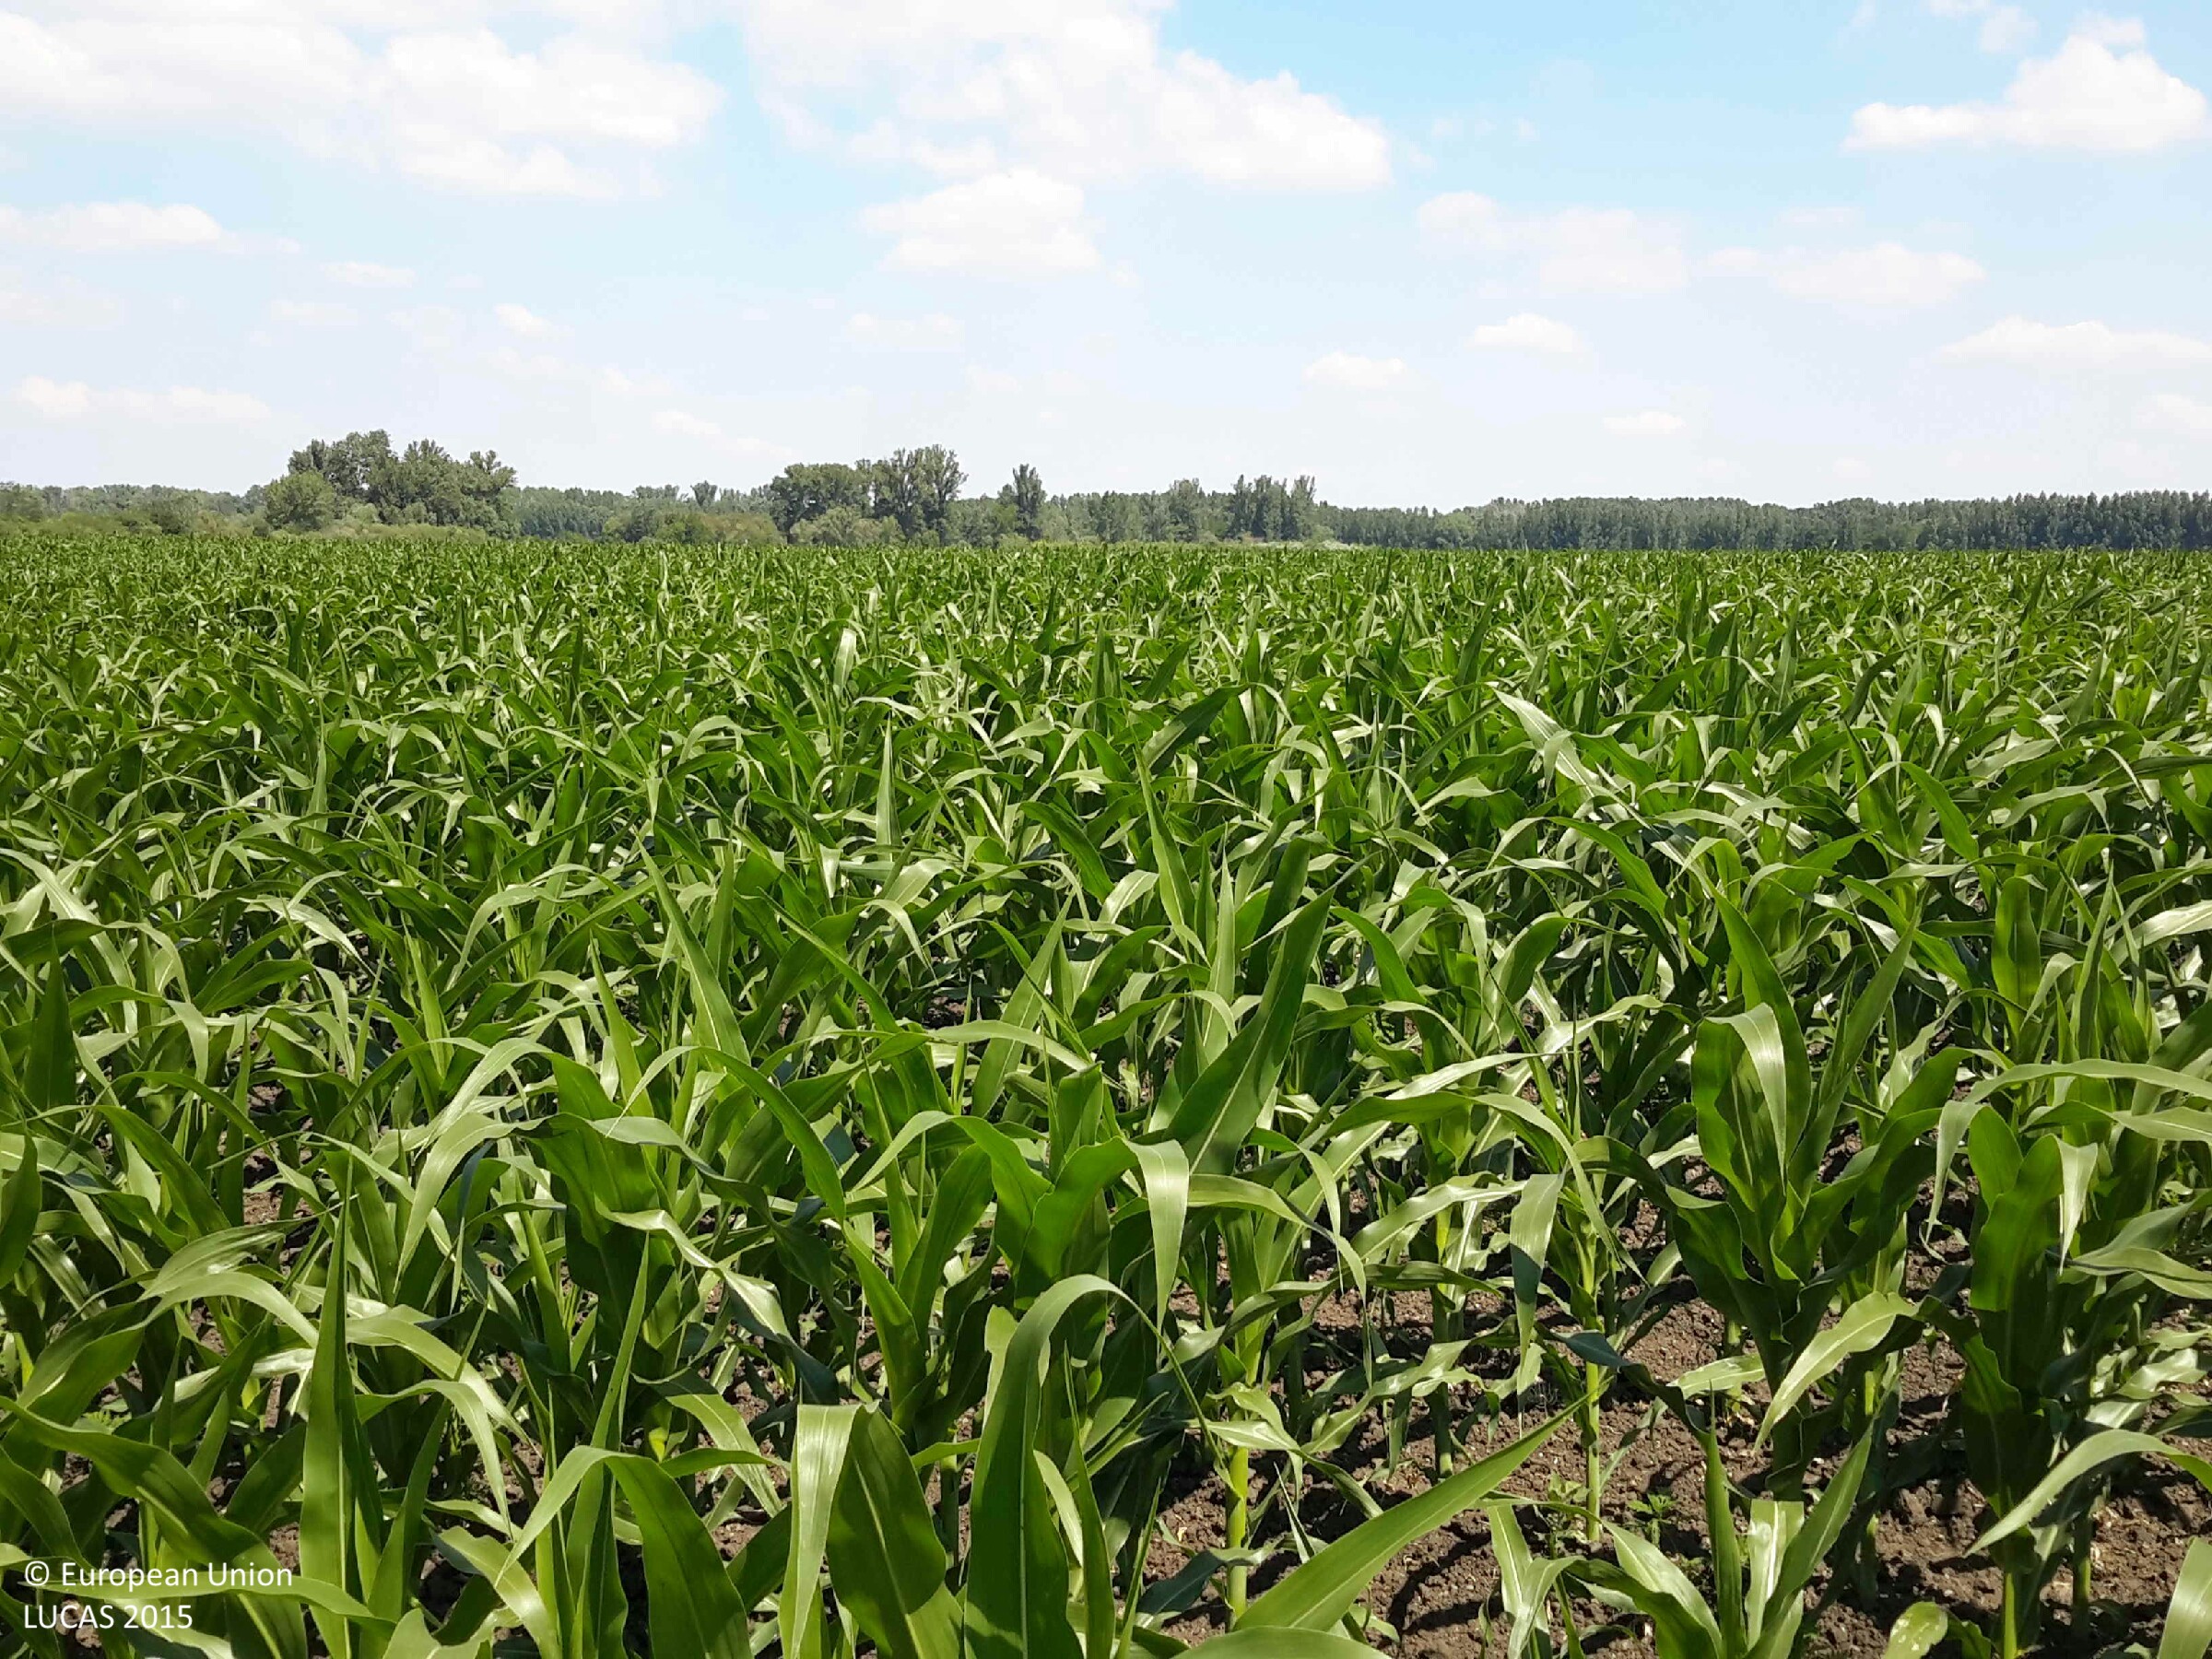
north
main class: Cropland
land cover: Maize
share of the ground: > 75 %
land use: Agriculture (excluding fallow land and kitchen gardens)
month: June
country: HU
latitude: 47.6836
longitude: 17.4283
